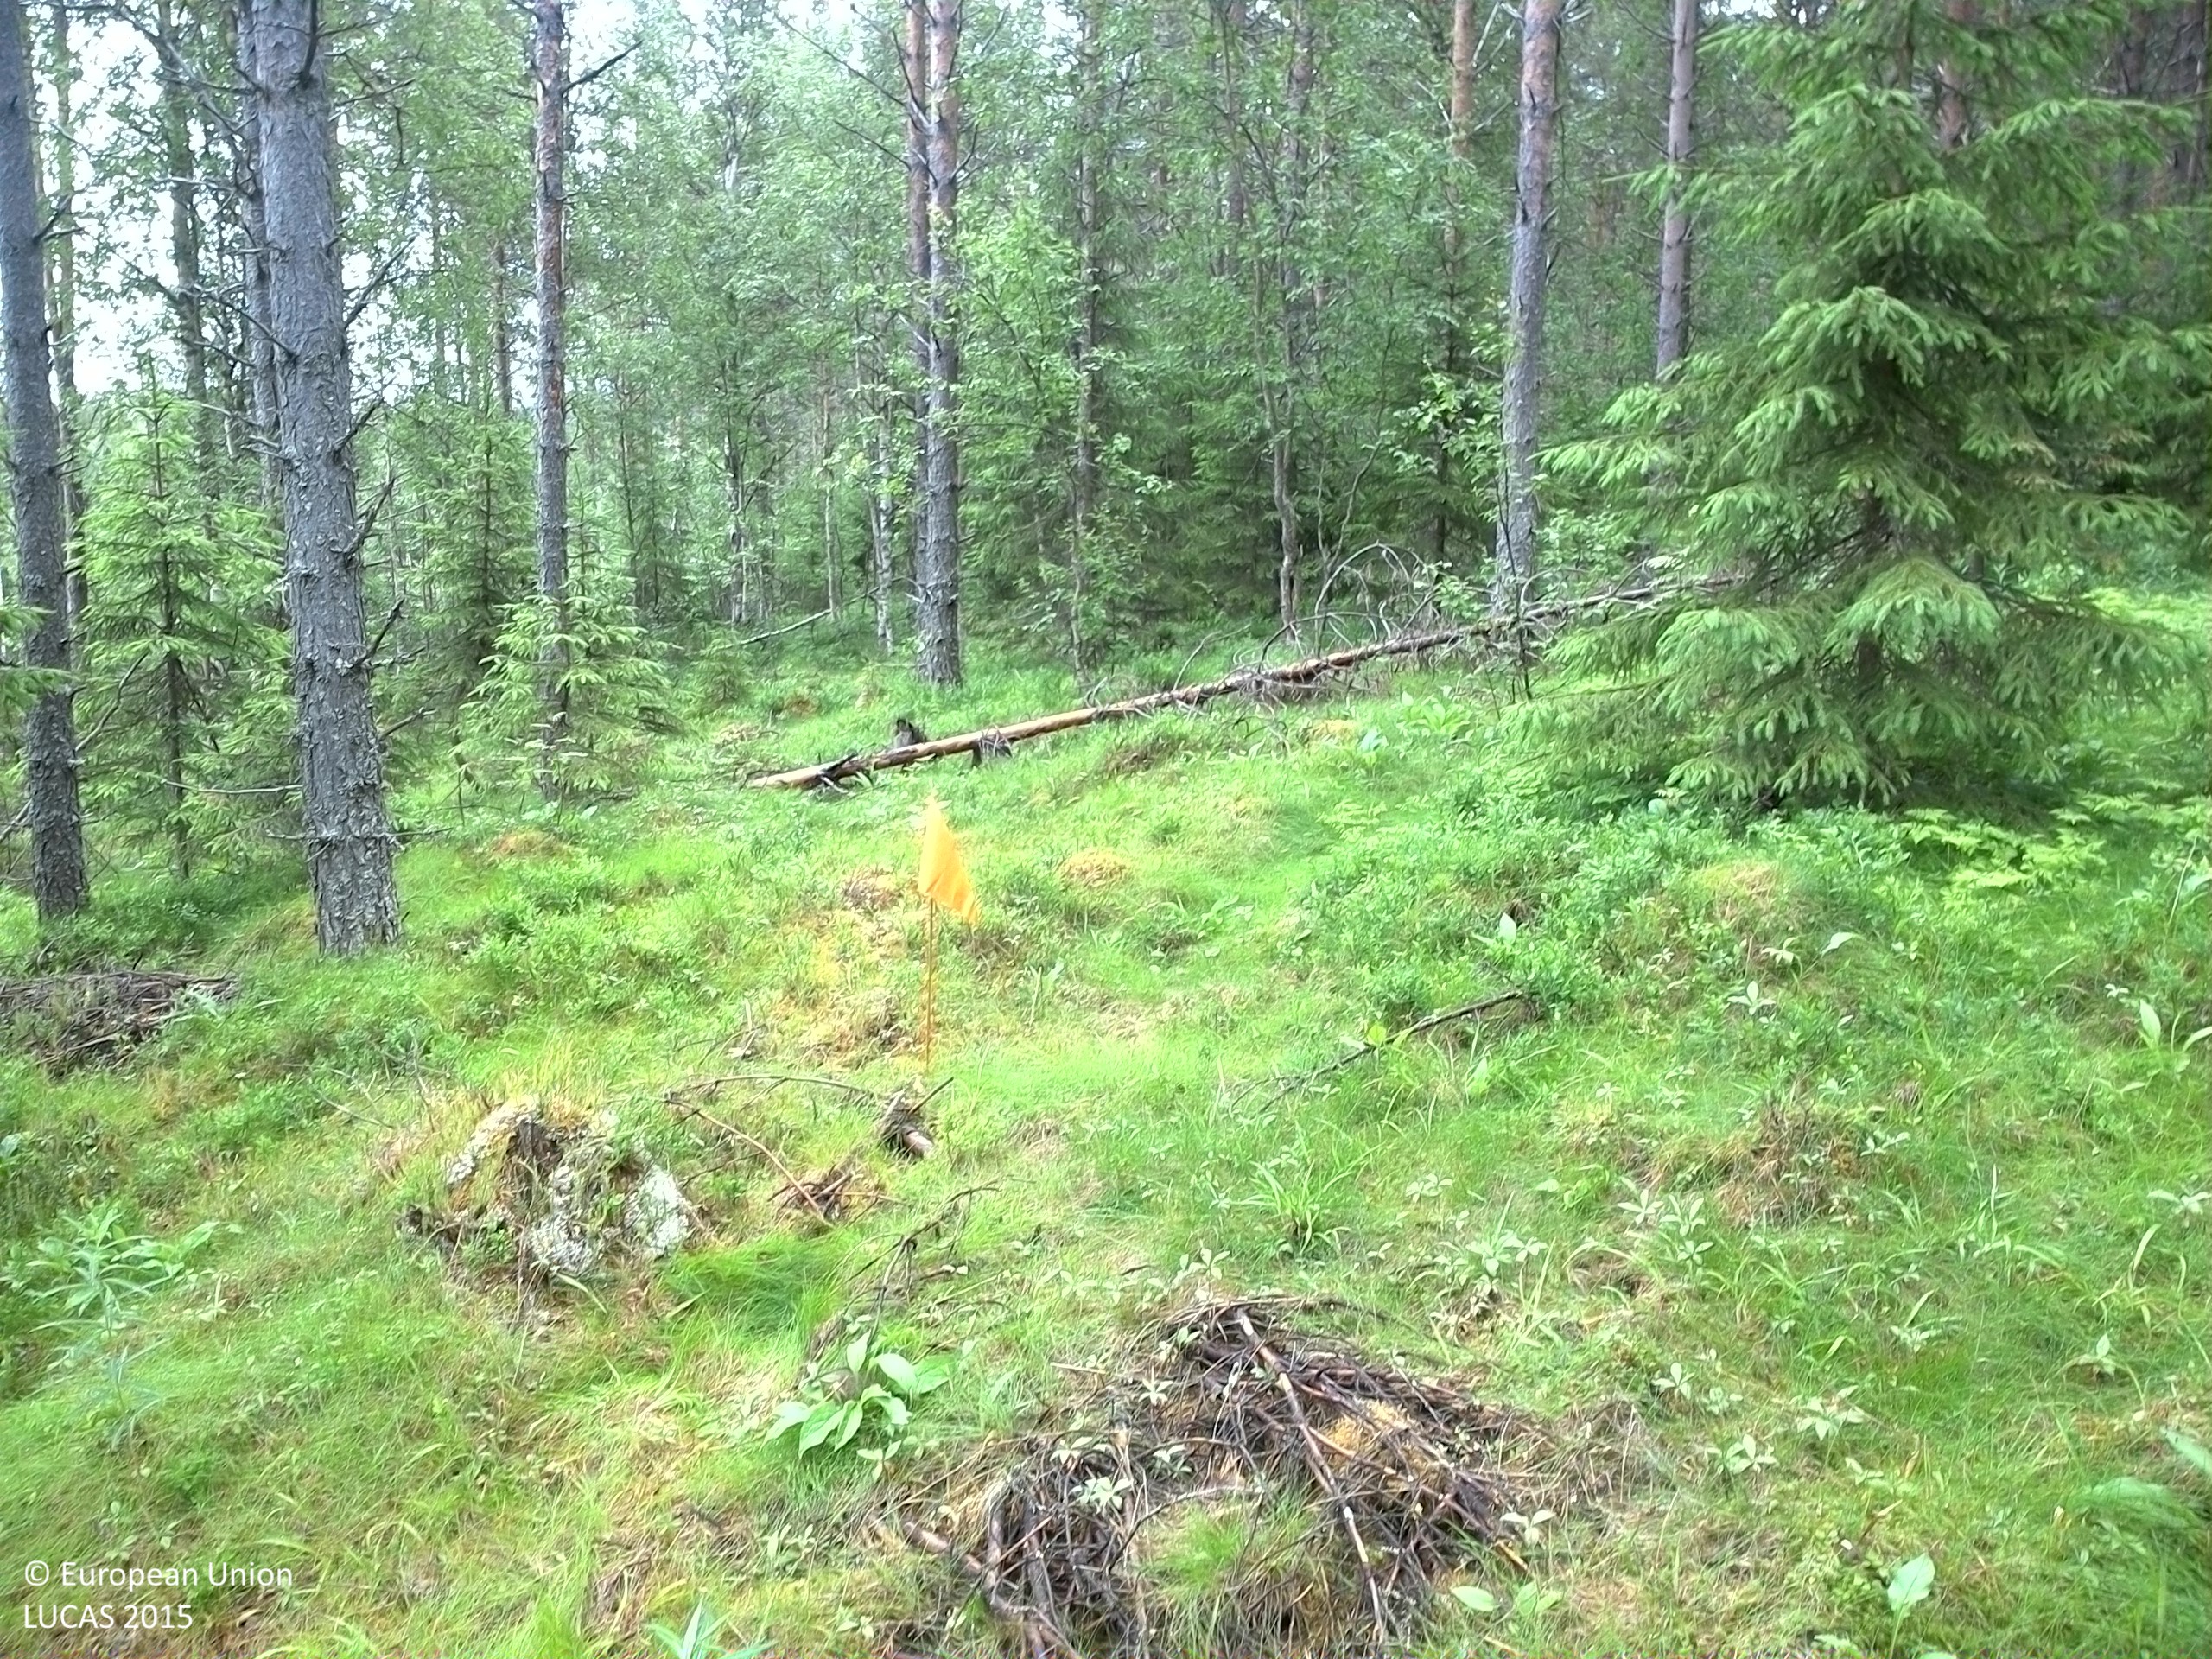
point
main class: Woodland
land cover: Pine dominated coniferous woodland
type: boreal forest
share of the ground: 50 - 75 %
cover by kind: coniferous forest trees 55 %, herbaceous plants 15 %, broadleaved forest trees 10 %, shrubs 10 %, lichens and mosses 10 %
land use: Forestry
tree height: > 5 m
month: July
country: SE
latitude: 63.6111
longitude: 18.7482
